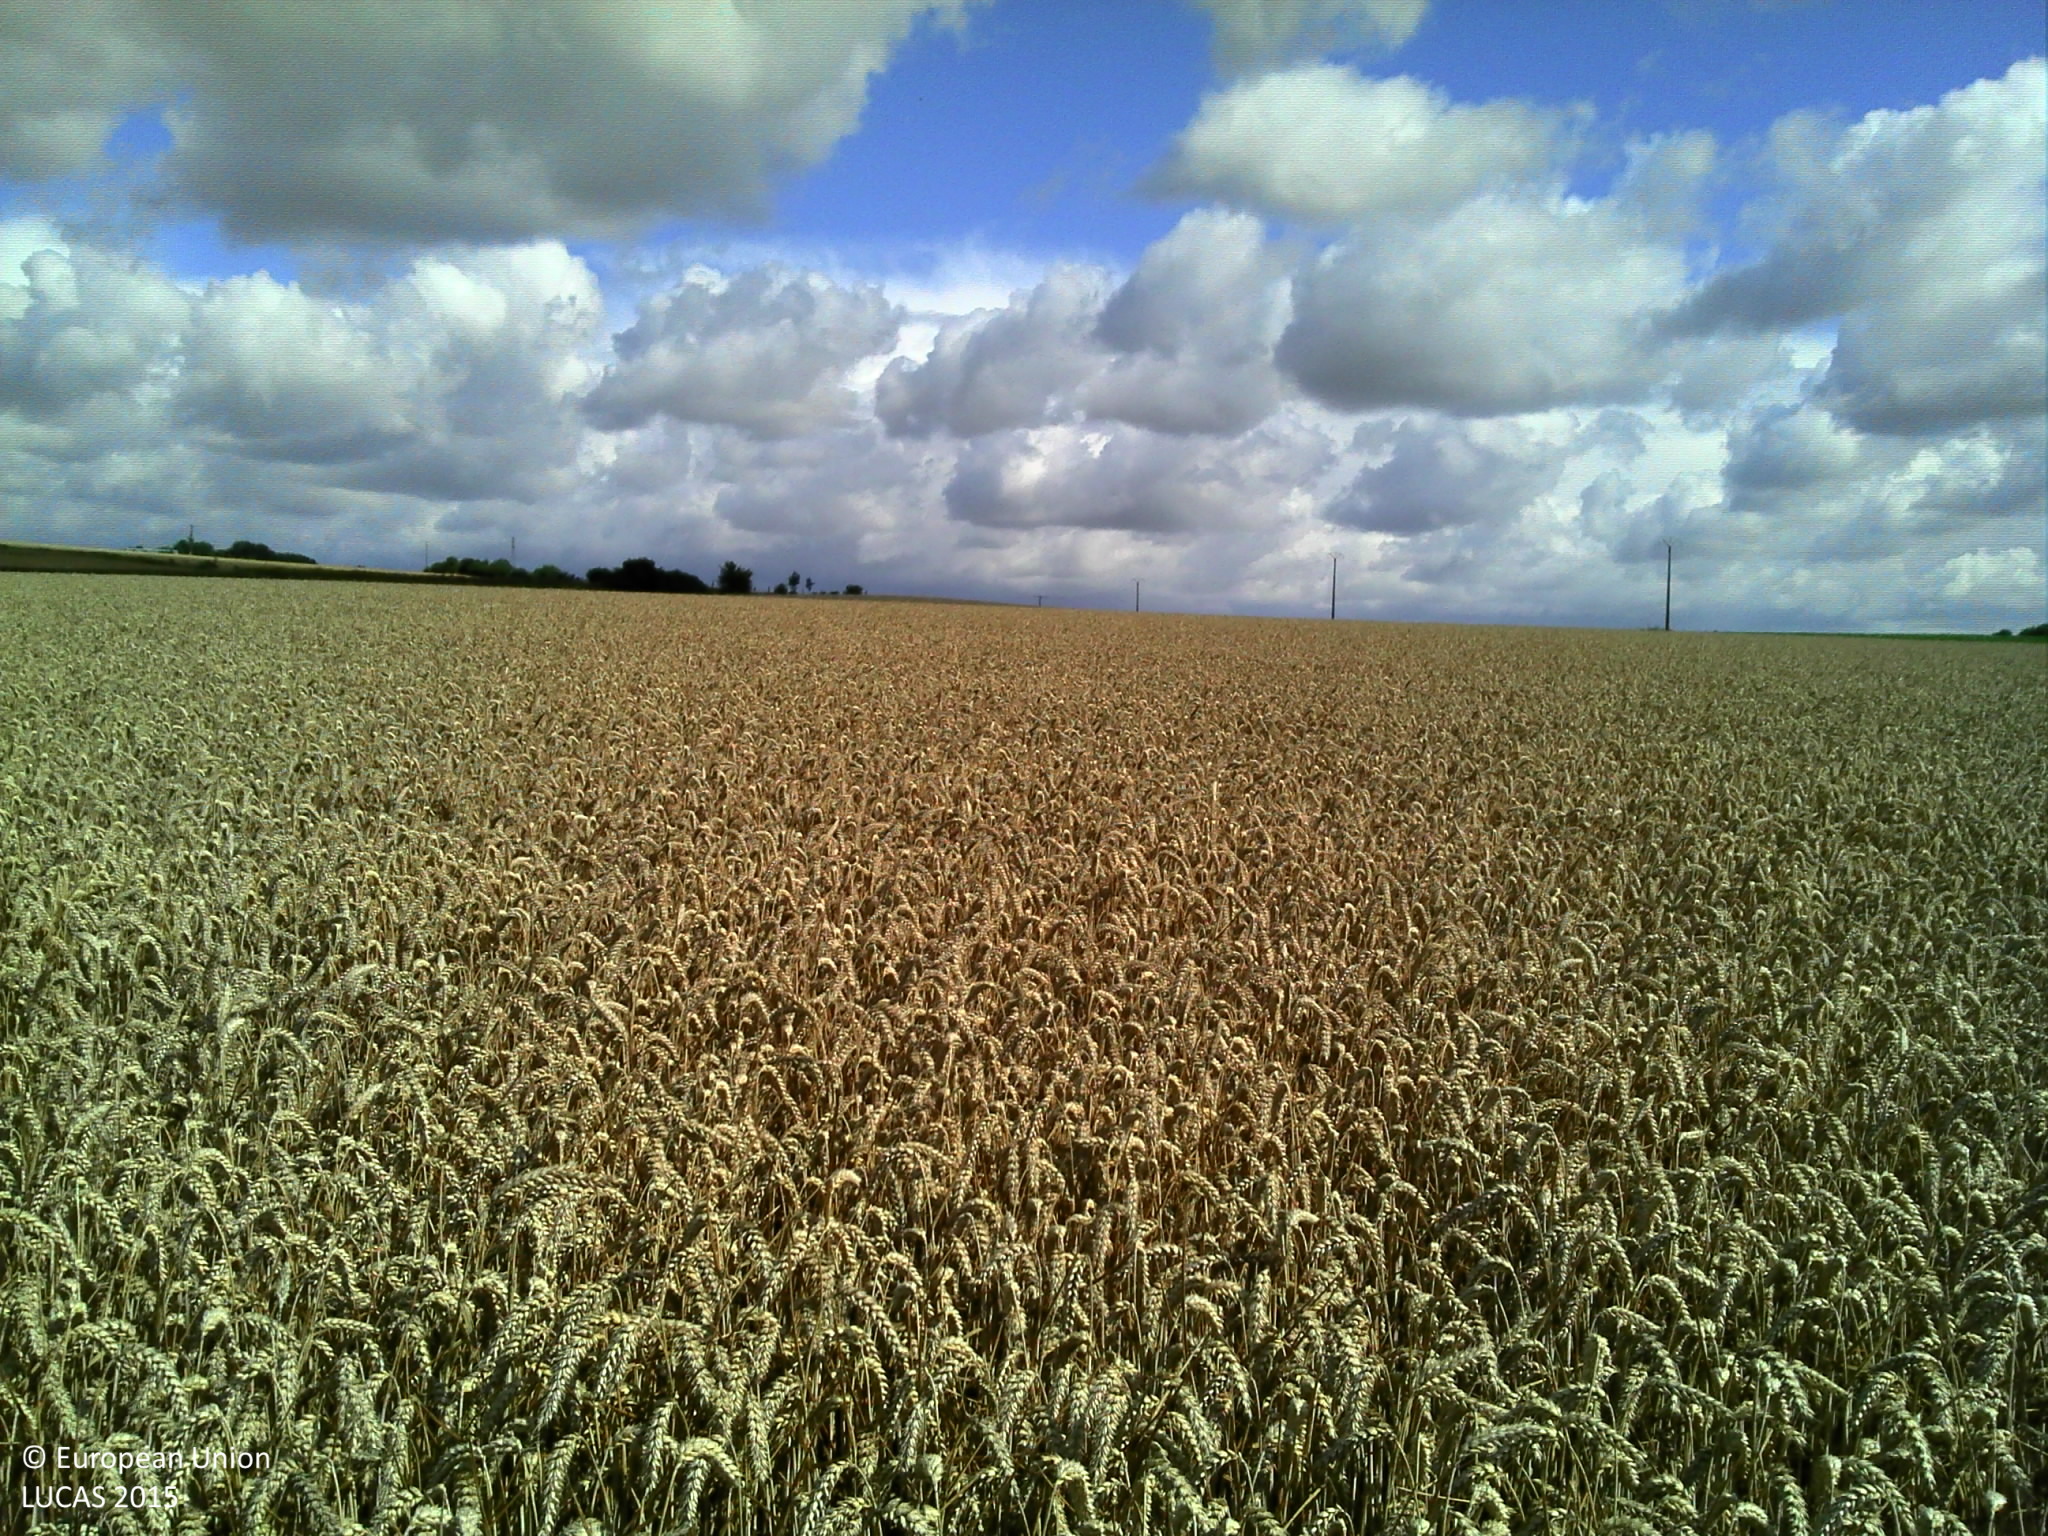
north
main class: Cropland
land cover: Common wheat
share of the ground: > 75 %
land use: Agriculture (excluding fallow land and kitchen gardens)
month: July
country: FR
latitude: 49.9590
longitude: 2.5583
